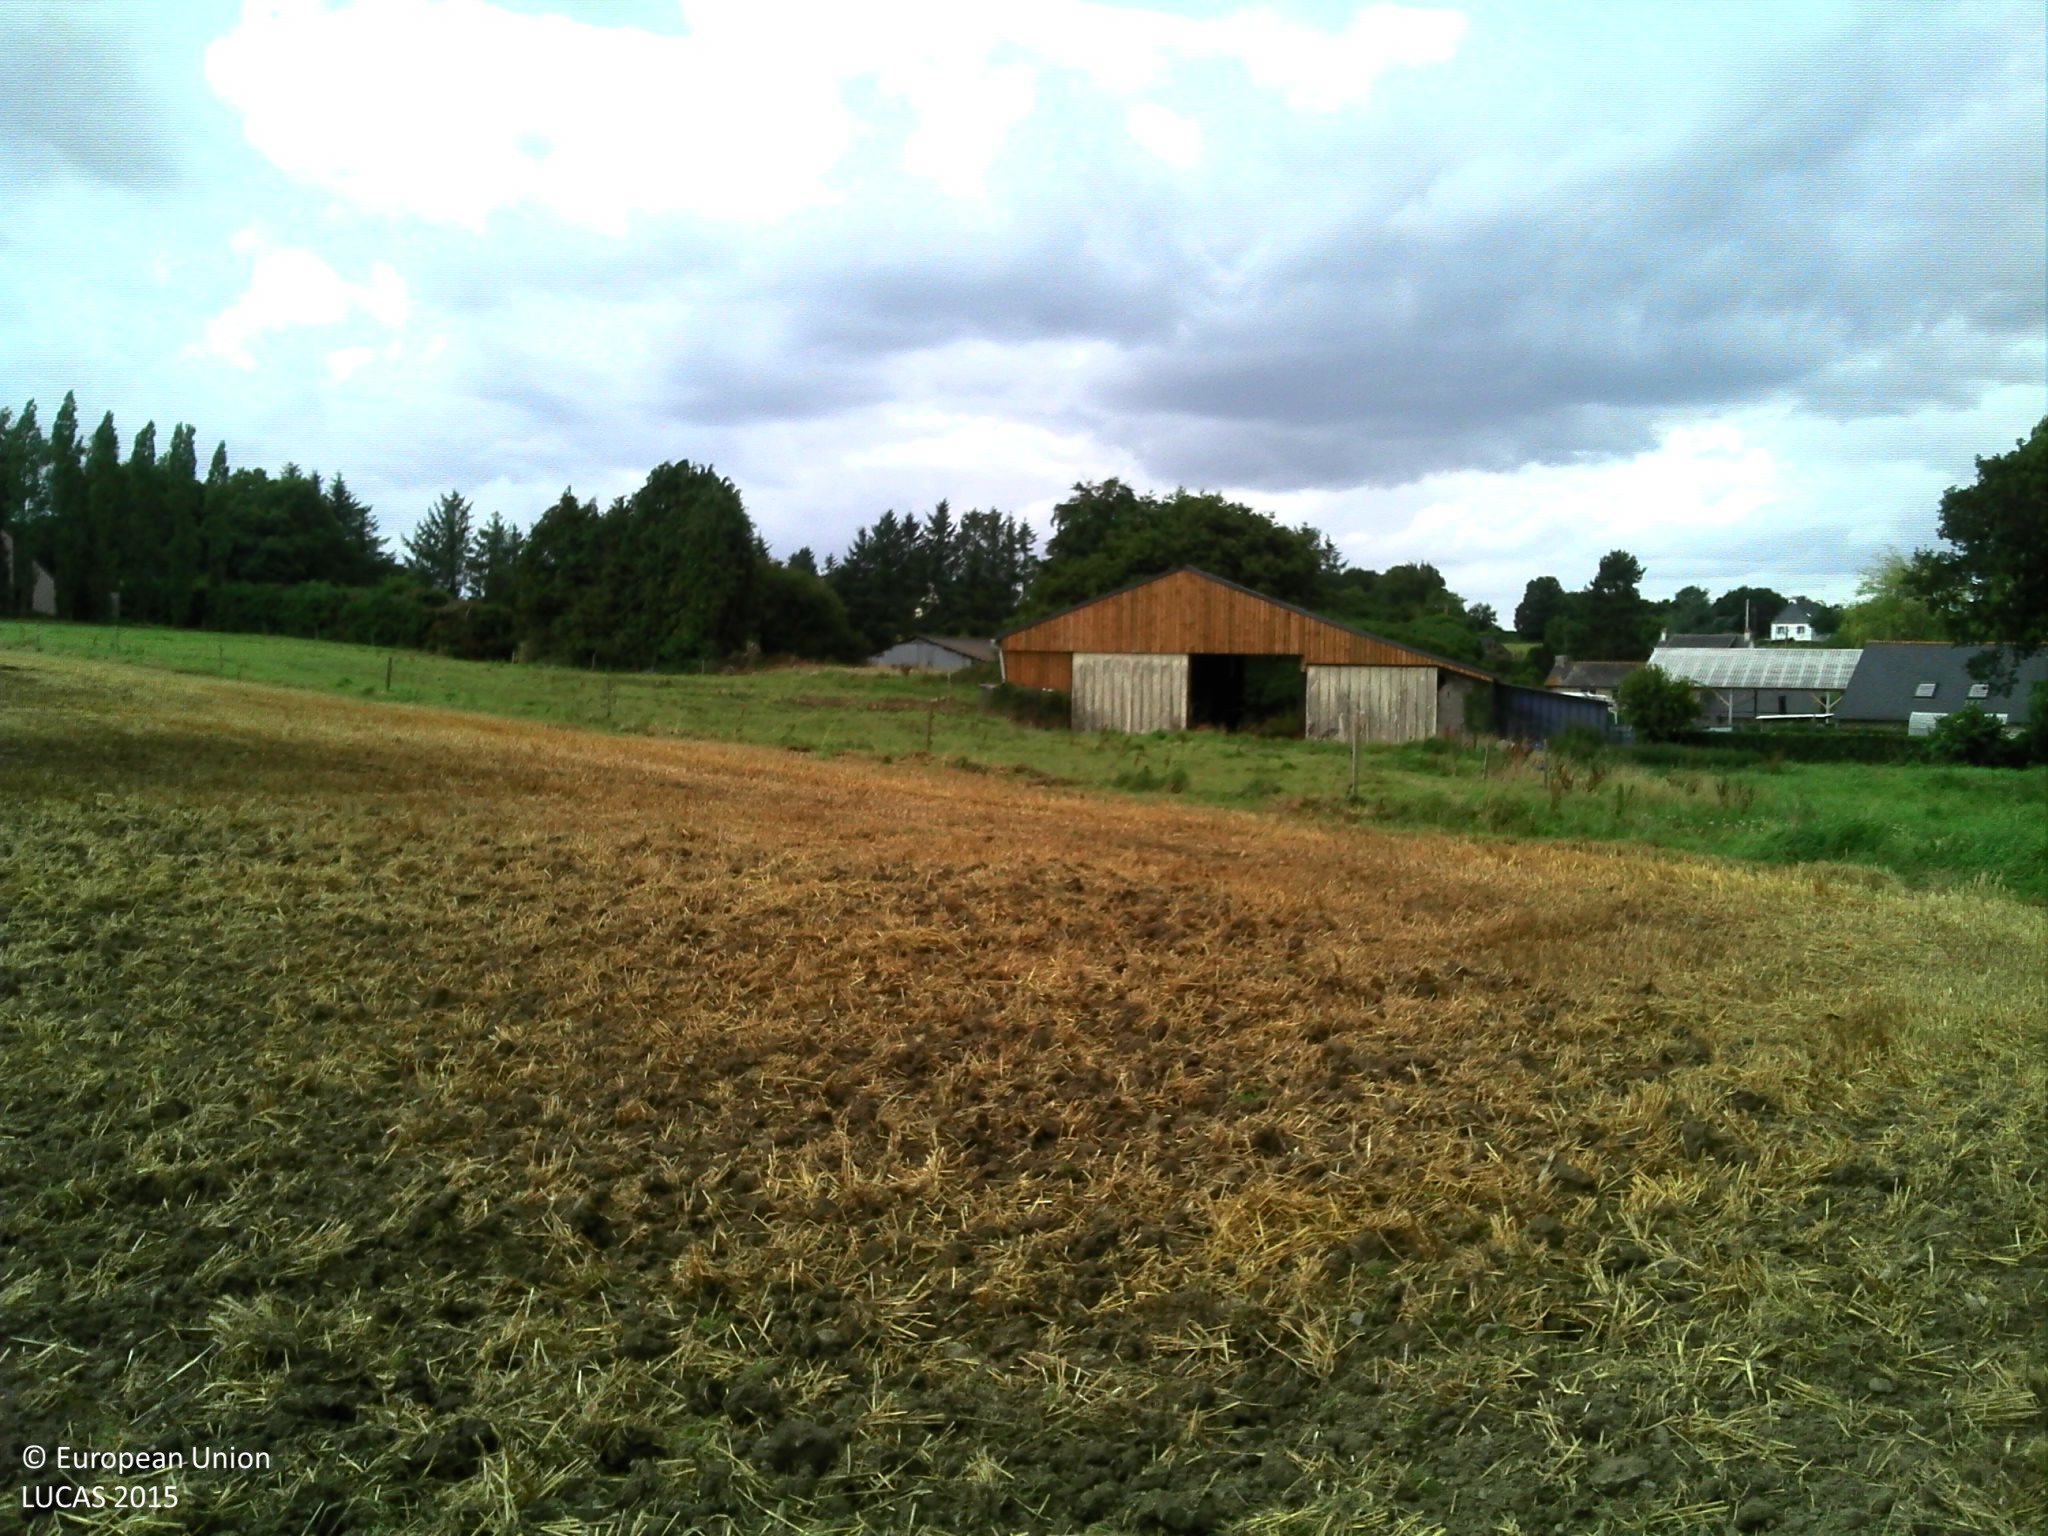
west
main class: Cropland
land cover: Maize
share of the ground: > 75 %
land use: Agriculture (excluding fallow land and kitchen gardens)
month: August
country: FR
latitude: 48.2954
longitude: -3.2429
